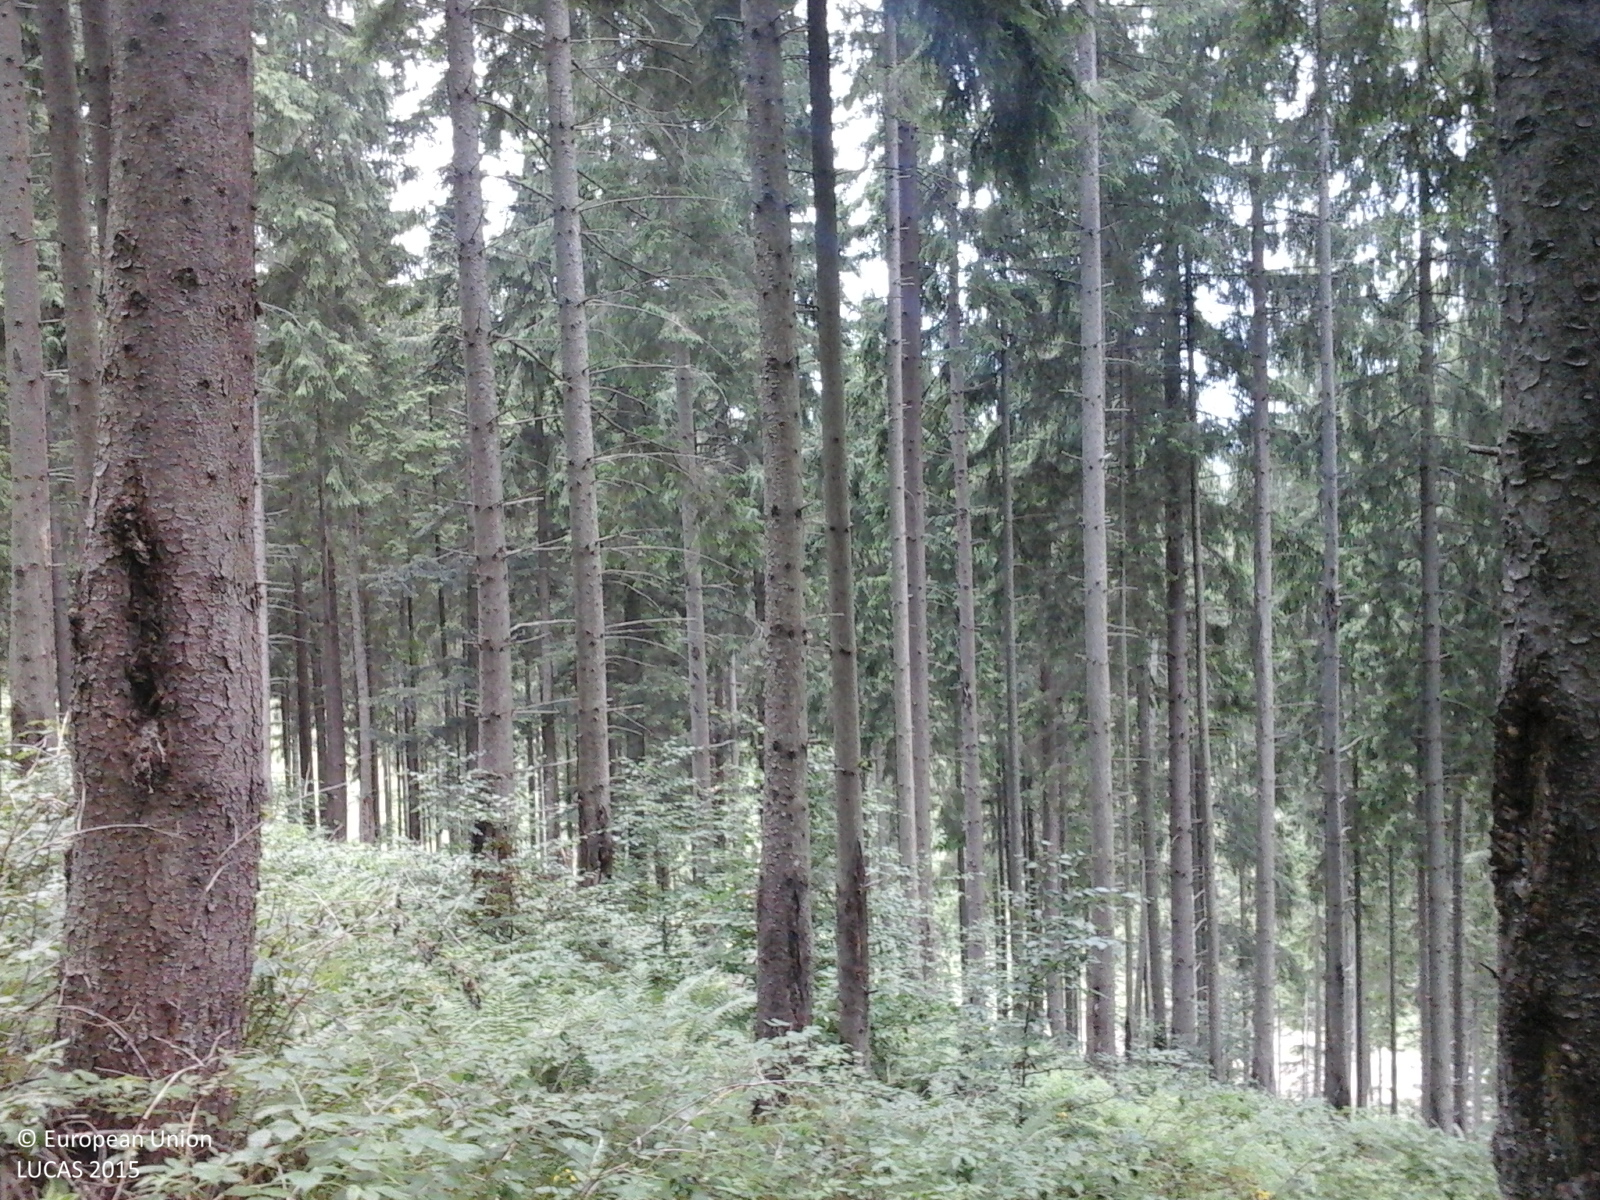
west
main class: Woodland
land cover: Spruce dominated coniferous woodland
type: alpine coniferous forest
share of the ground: > 75 %
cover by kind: coniferous forest trees 90 %, herbaceous plants 10 %
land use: Forestry
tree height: > 5 m
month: June
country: RO
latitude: 47.5667
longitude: 25.4408
